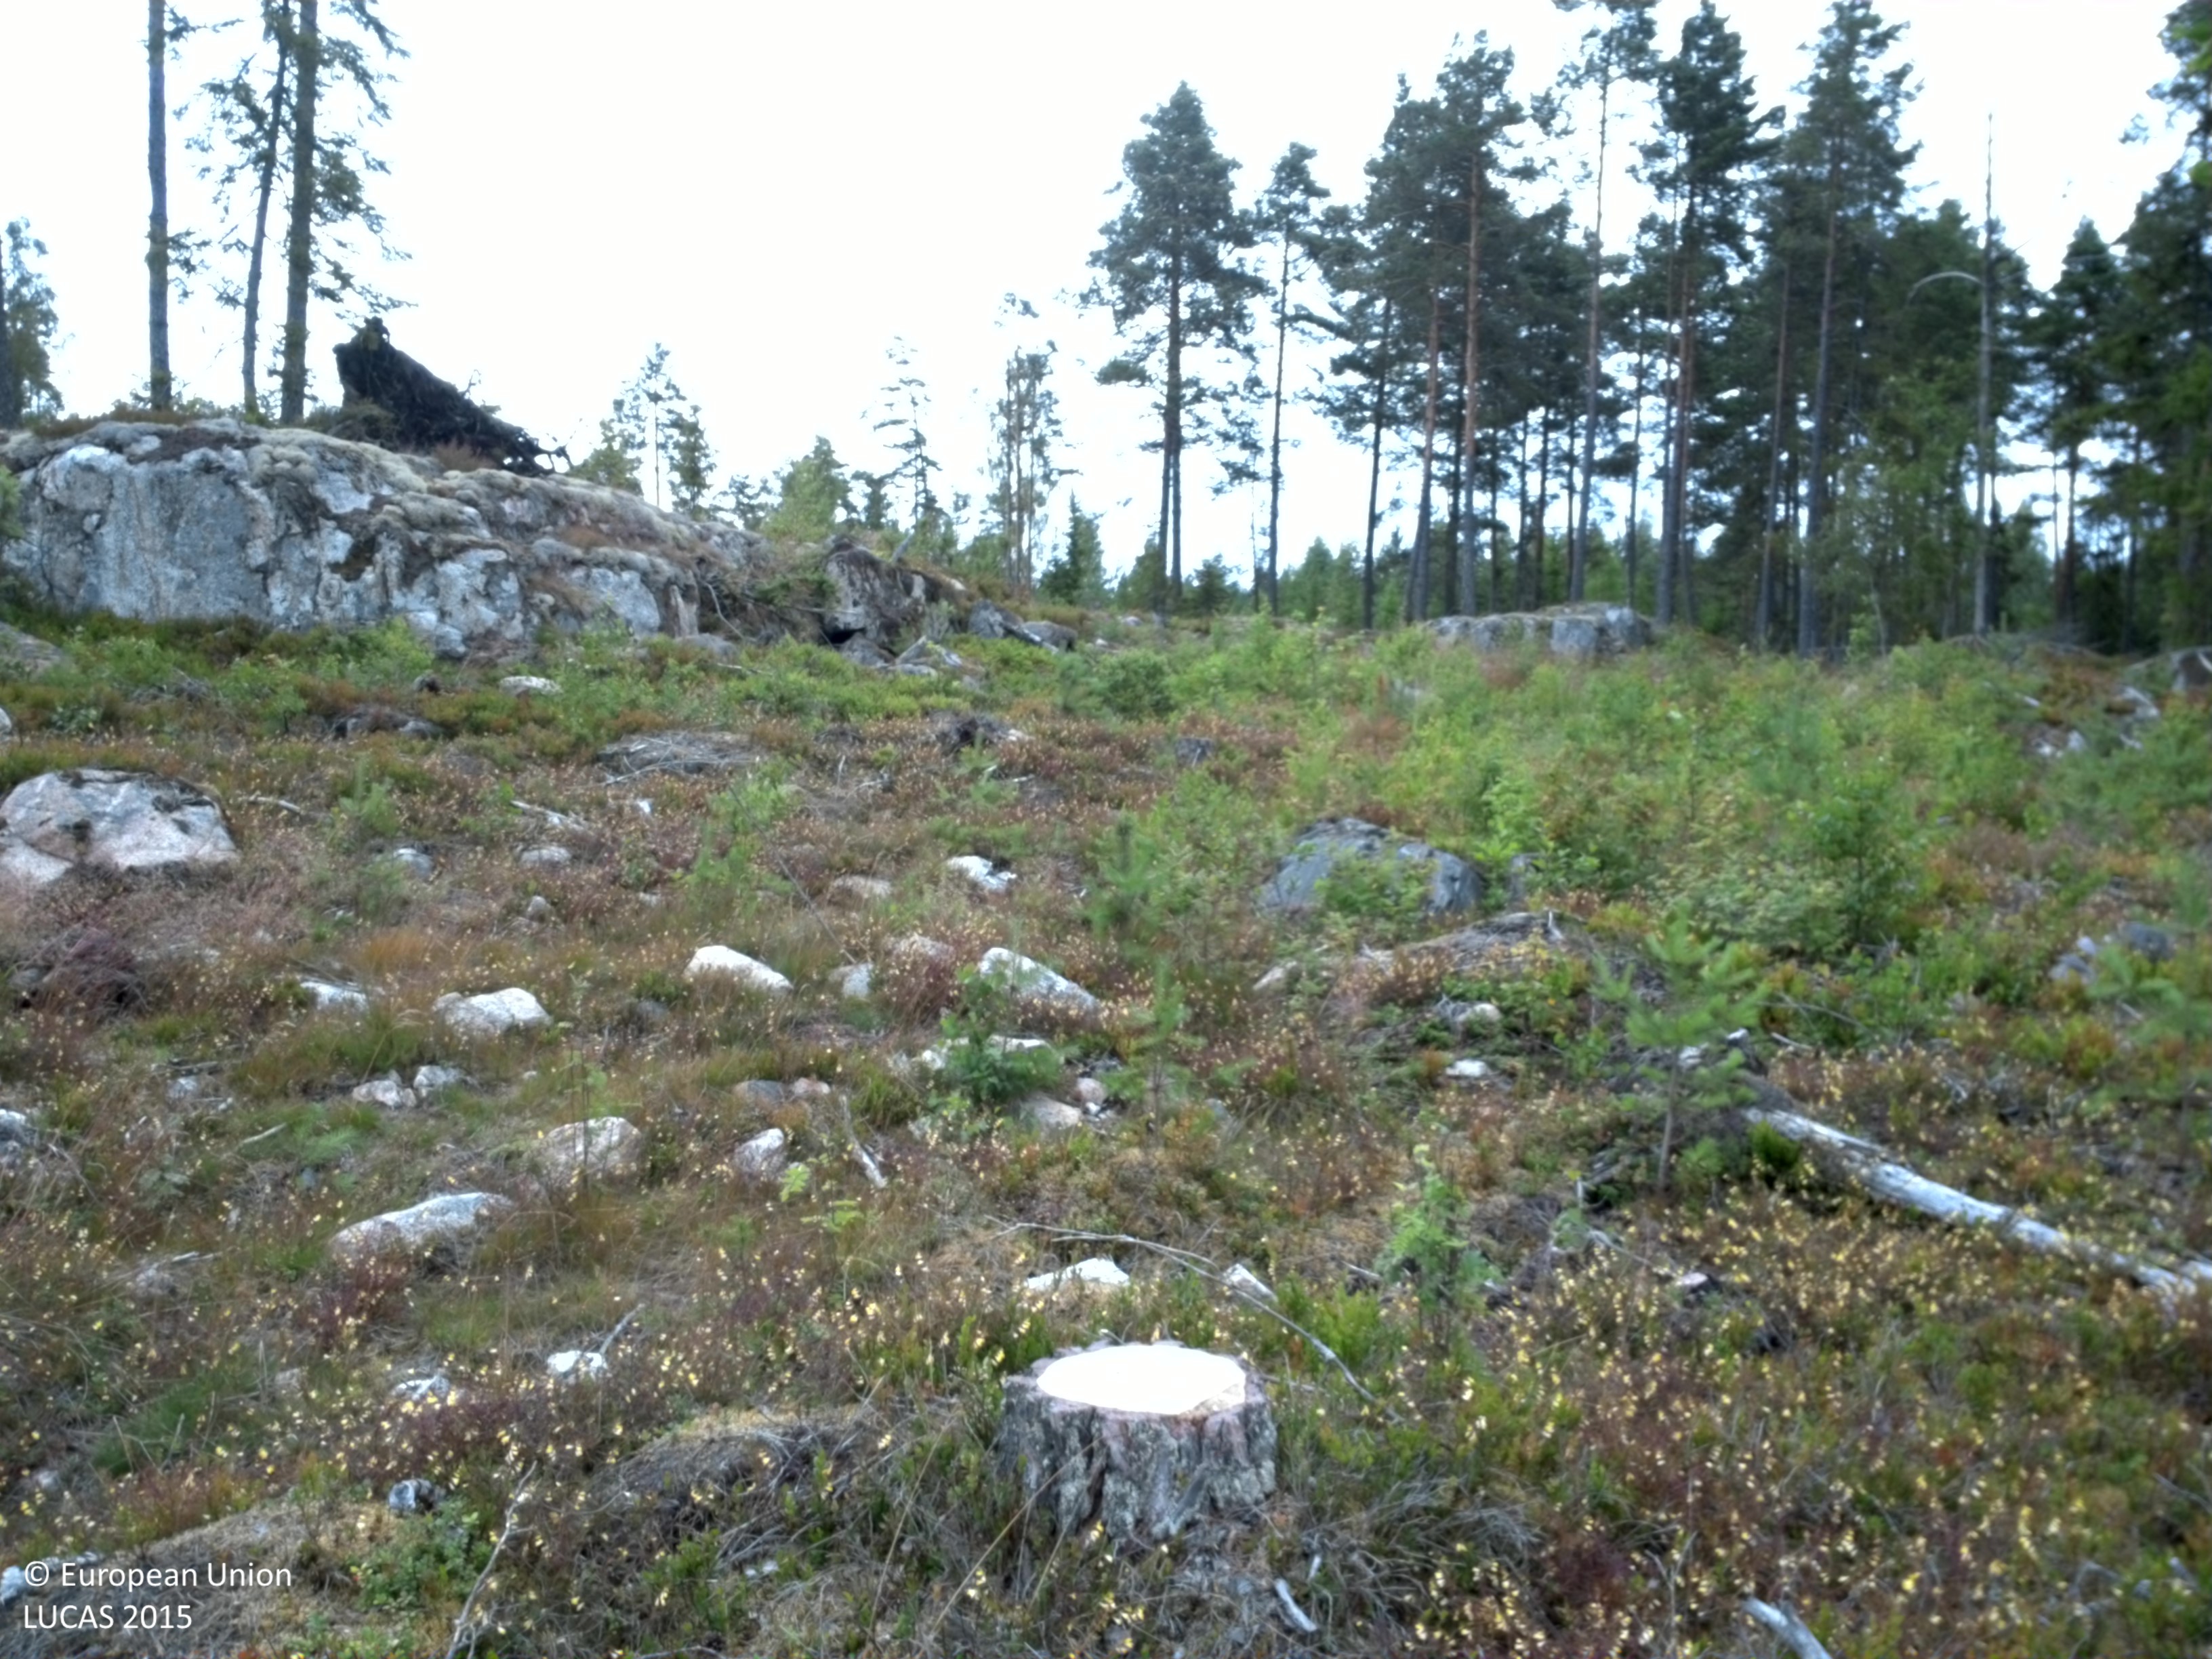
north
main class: Woodland
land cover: Pine dominated mixed woodland
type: boreal forest
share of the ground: 10 - 25 %
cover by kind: herbaceous plants 50 %, coniferous forest trees 15 %, lichens and mosses 15 %, broadleaved forest trees 10 %, shrubs 10 %
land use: Forestry
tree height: < 5 m
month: July
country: SE
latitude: 58.7435
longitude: 15.3671
